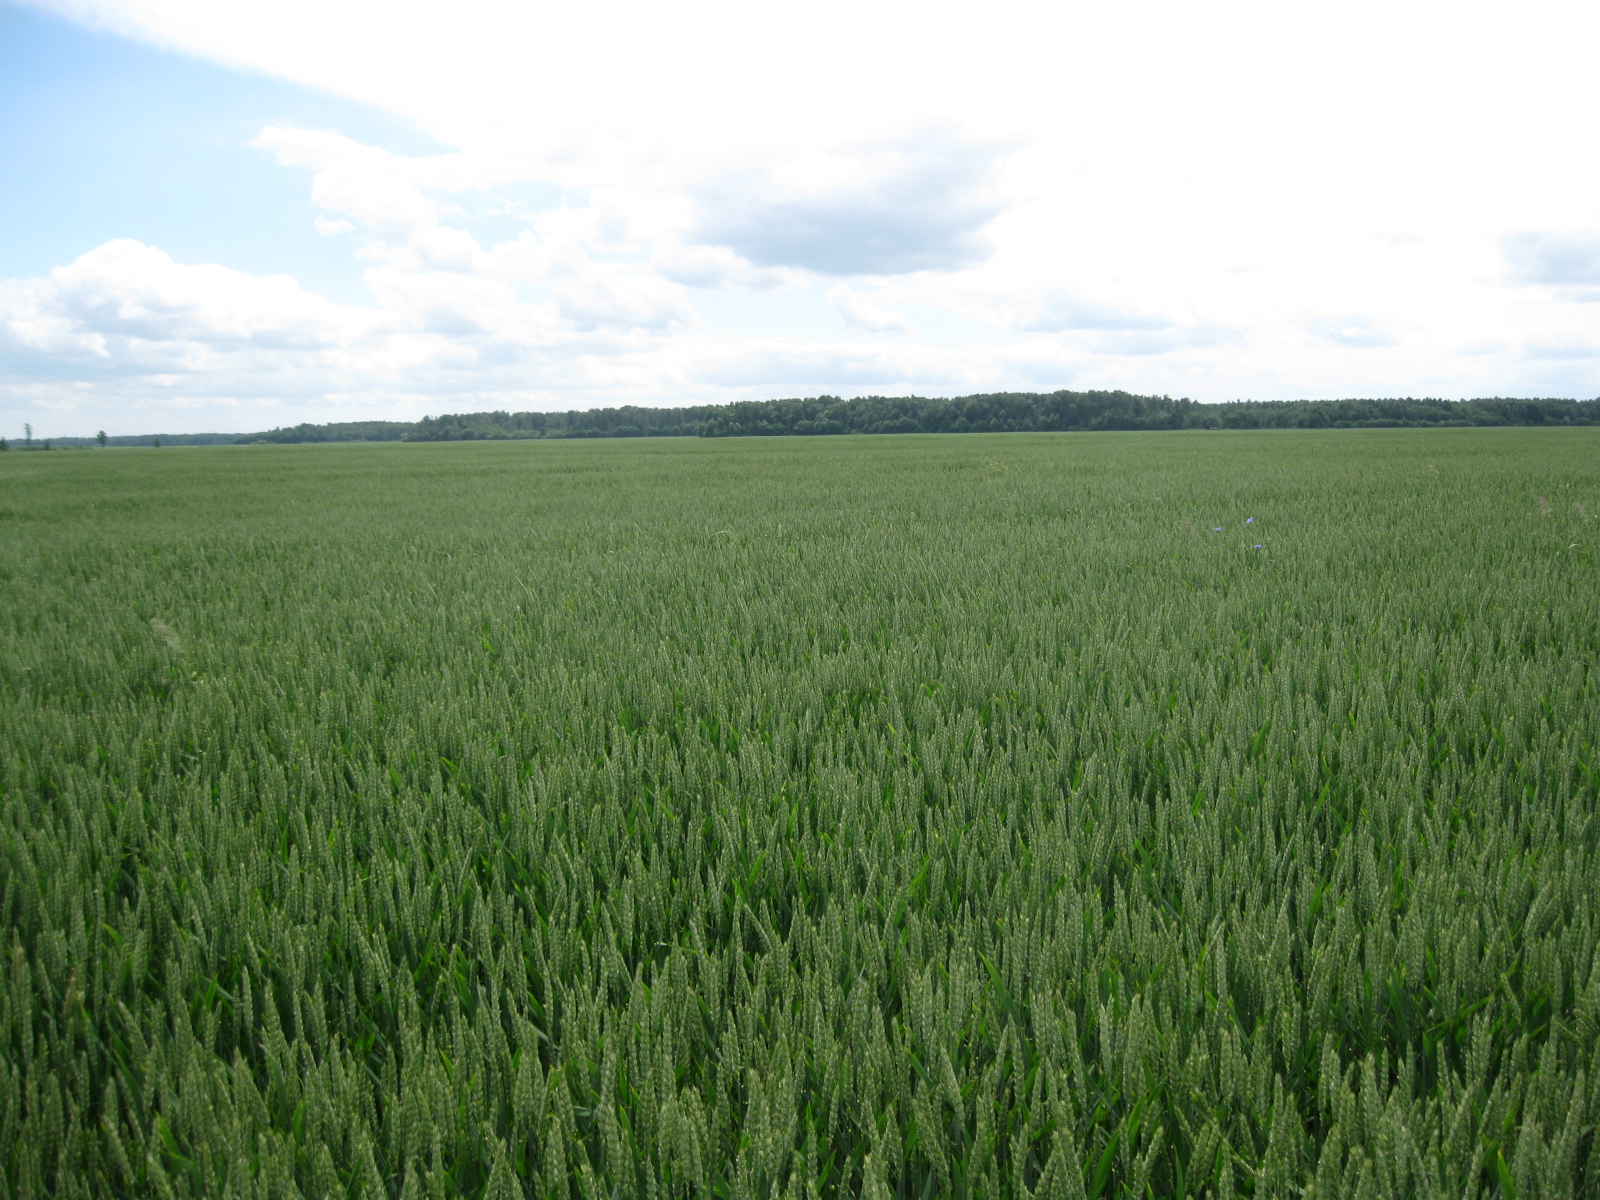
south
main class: Cropland
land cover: Common wheat
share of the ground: > 75 %
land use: Agriculture (excluding fallow land and kitchen gardens)
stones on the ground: < 10 %
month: June
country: LT
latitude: 55.5900
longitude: 24.2313
